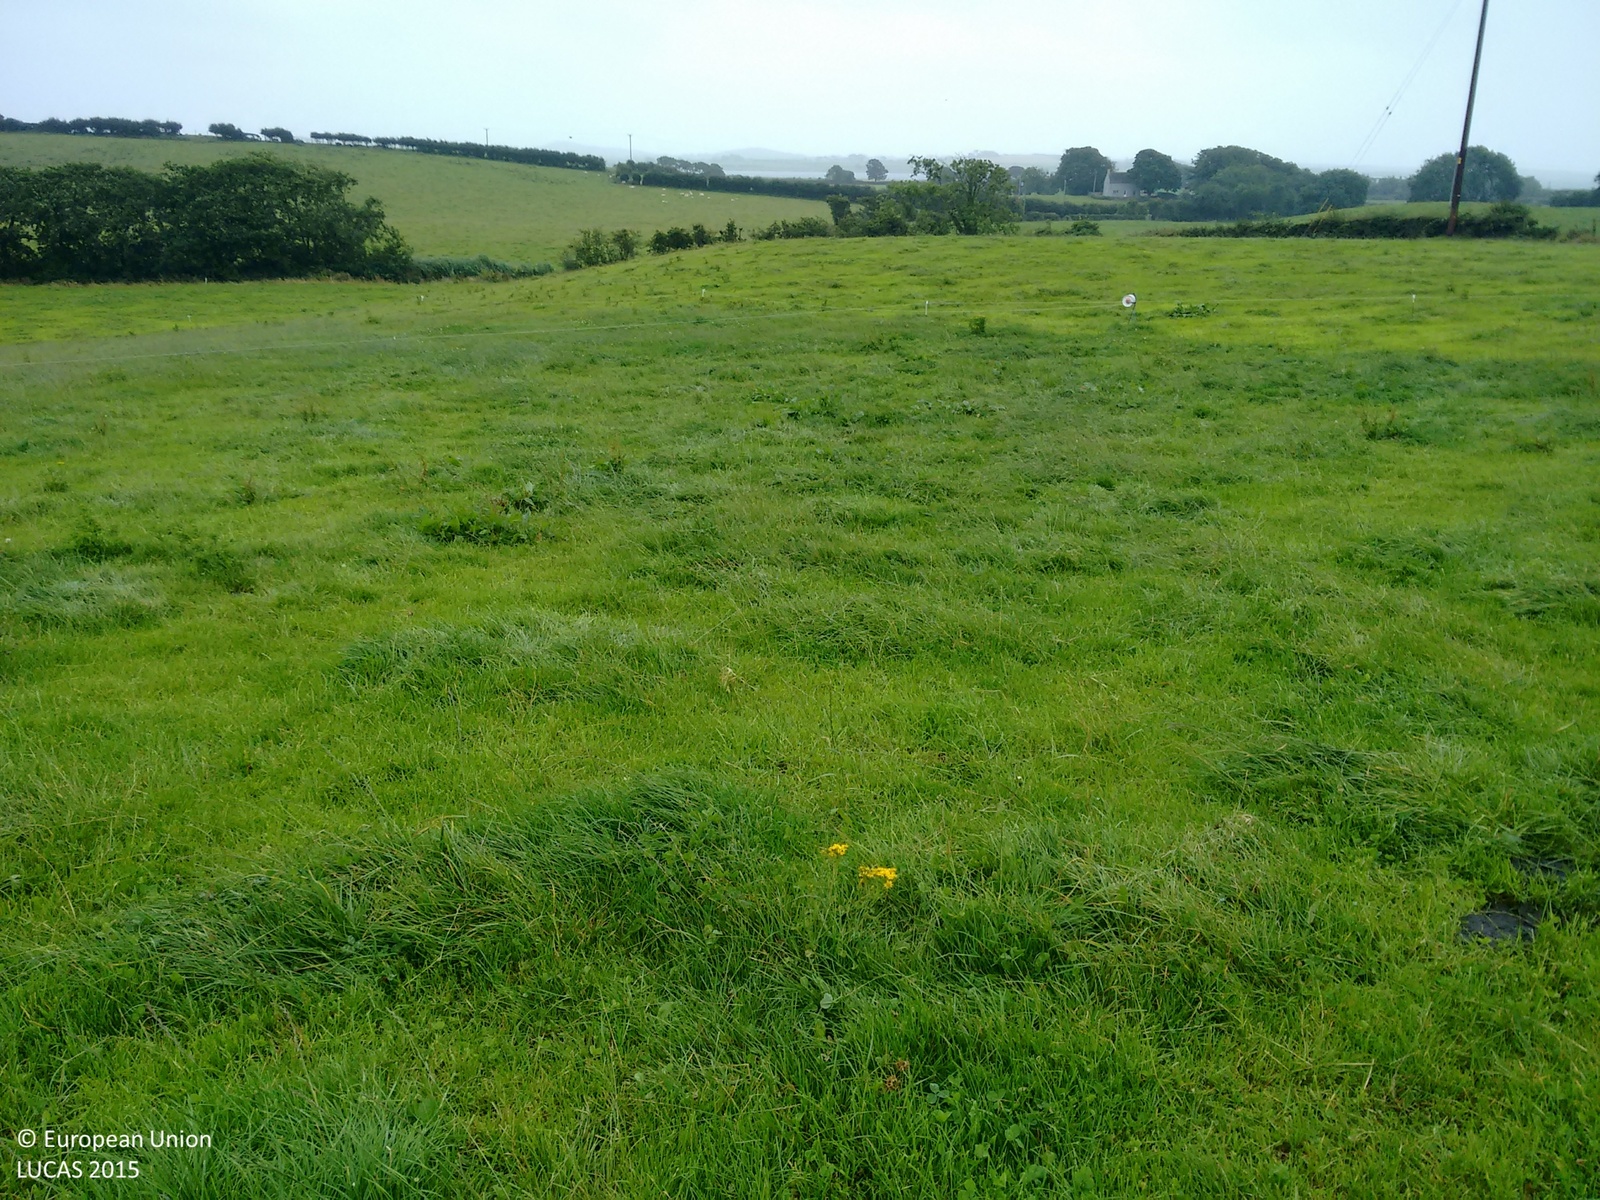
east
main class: Grassland
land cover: Grassland without tree/shrub cover
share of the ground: > 75 %
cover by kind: herbaceous plants 100 %
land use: Agriculture (excluding fallow land and kitchen gardens)
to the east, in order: Grassland without tree/shrub cover; Fences; Grassland without tree/shrub cover; Fences; Abandoned hedges; Grassland without tree/shrub cover; Managed hedges; Grassland without tree/shrub cover; Managed hedges; Grassland without tree/shrub cover
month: August
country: GB
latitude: 54.3492
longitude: -5.5602
